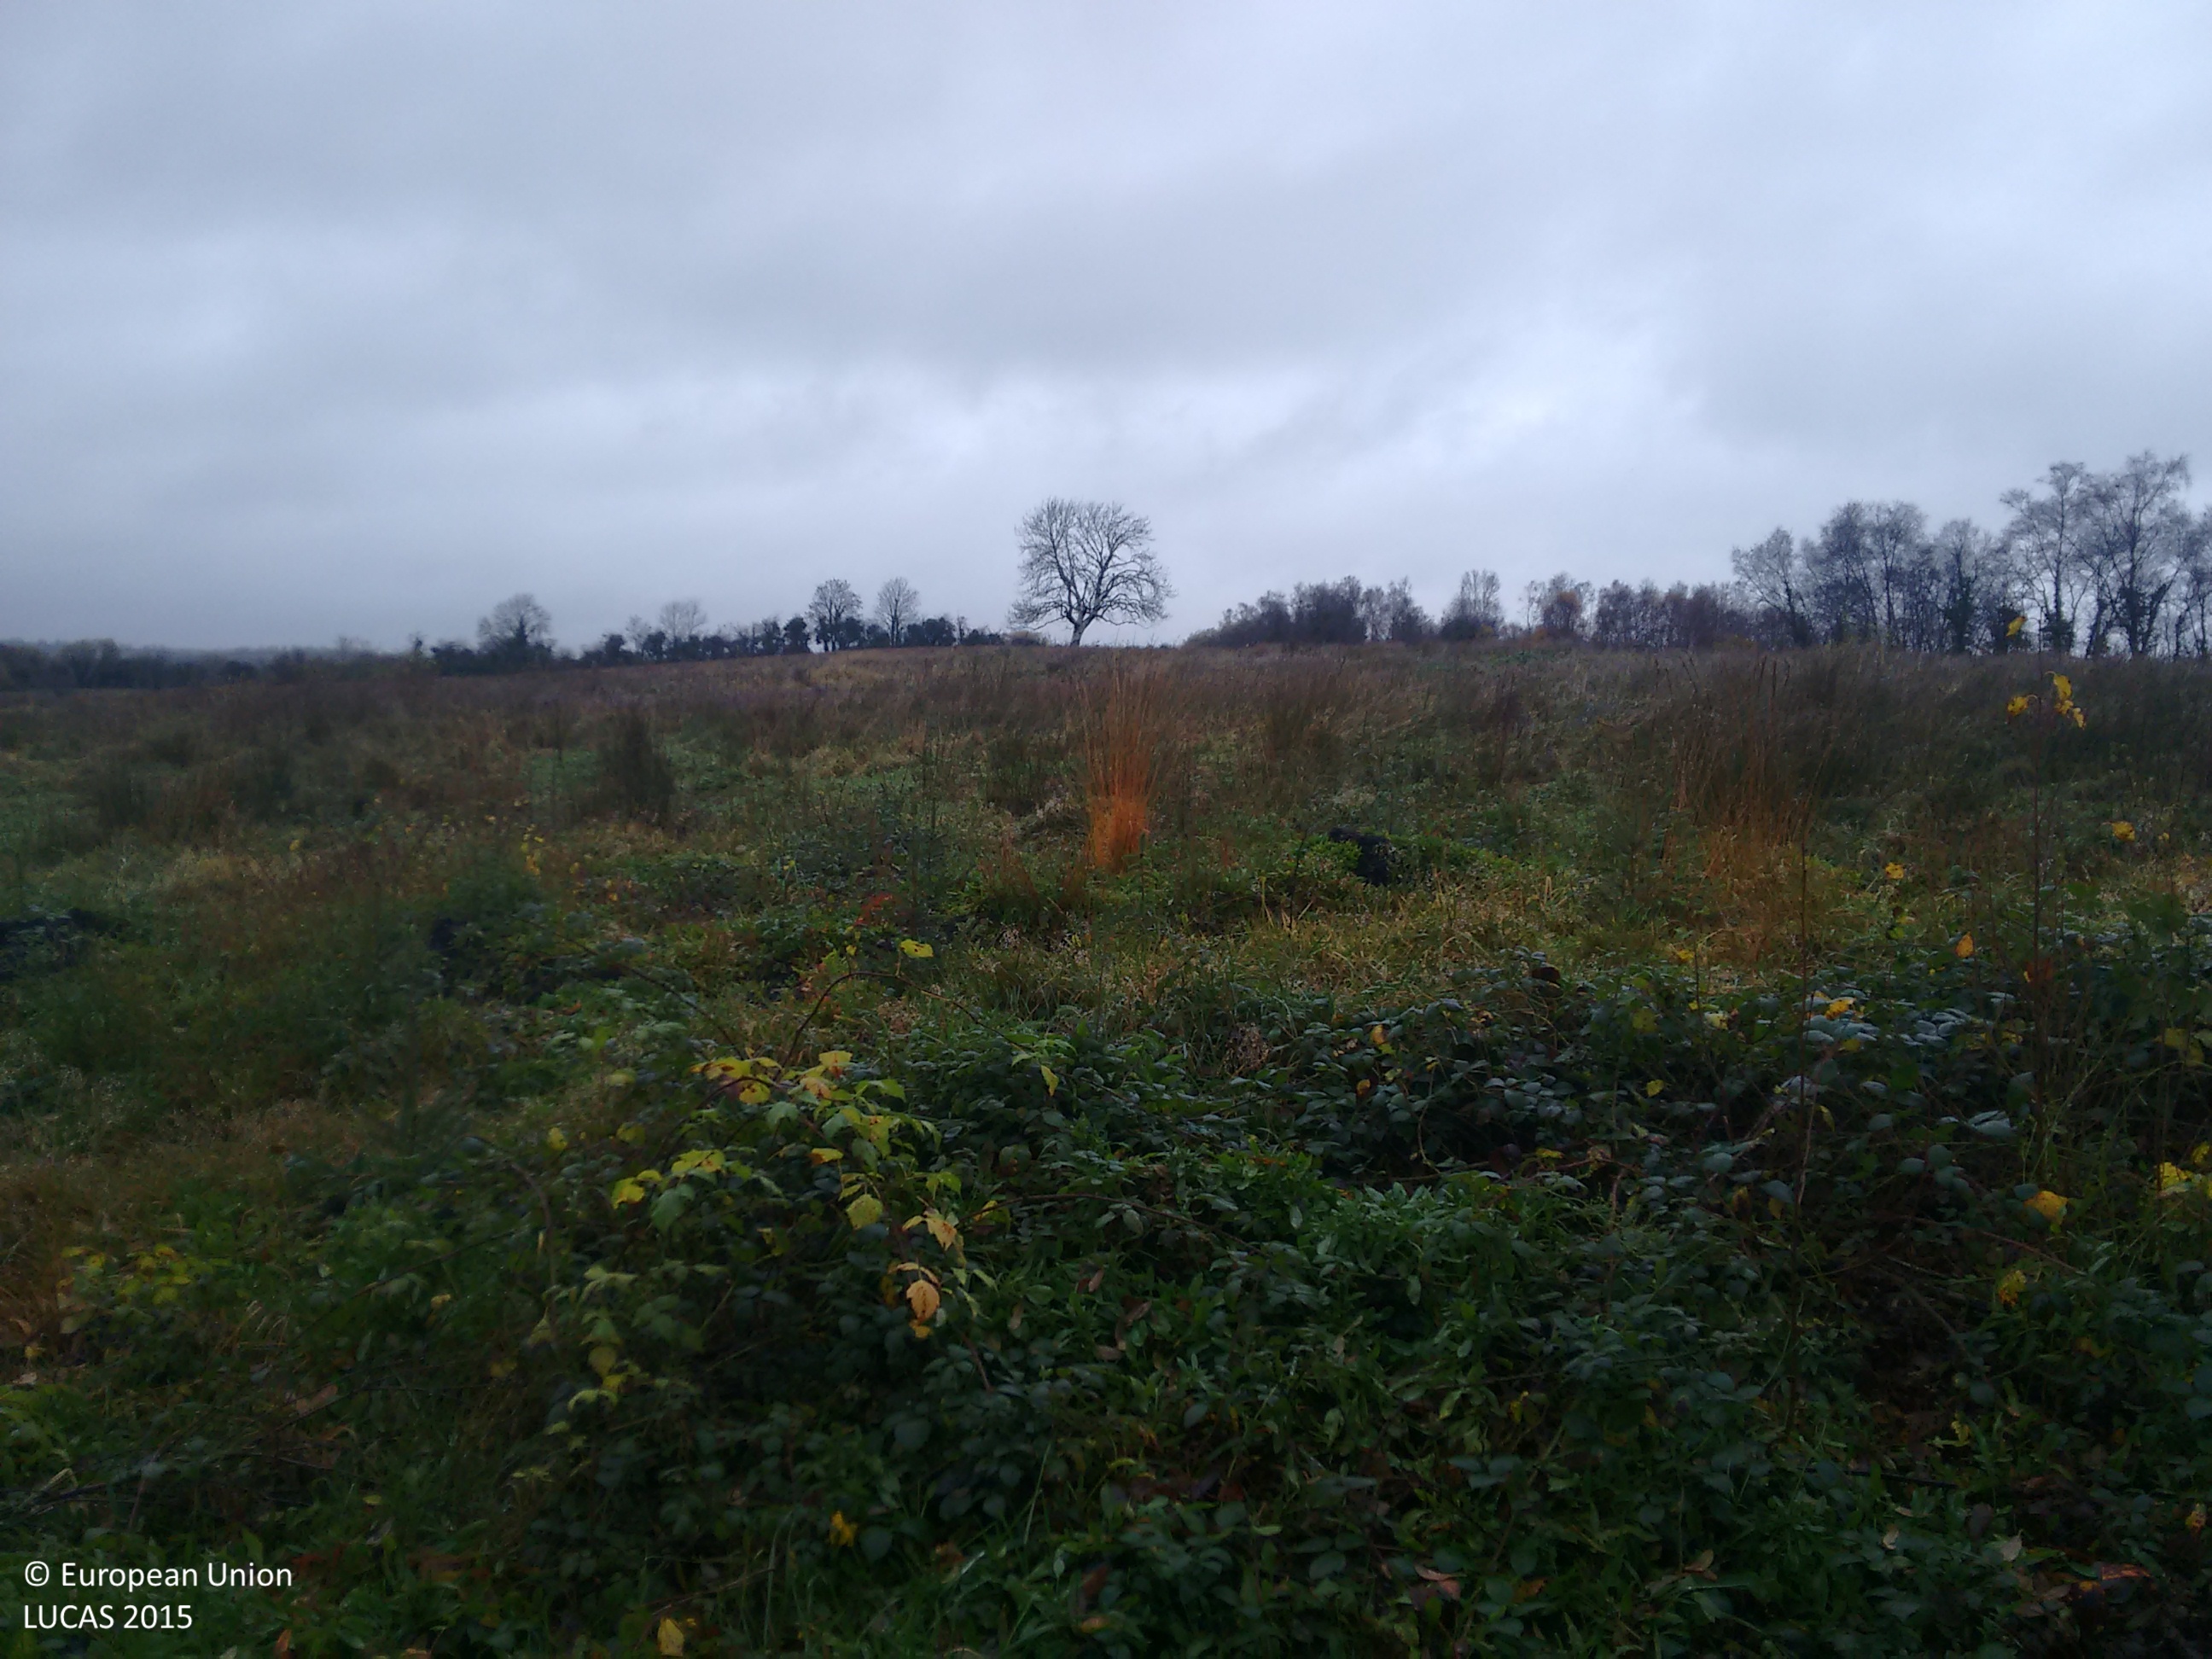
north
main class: Grassland
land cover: Spontaneously vegetated surfaces
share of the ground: > 75 %
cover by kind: herbaceous plants 95 %, shrubs 5 %
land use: Agriculture (excluding fallow land and kitchen gardens)
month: November
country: IE
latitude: 53.9361
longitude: -7.8855
